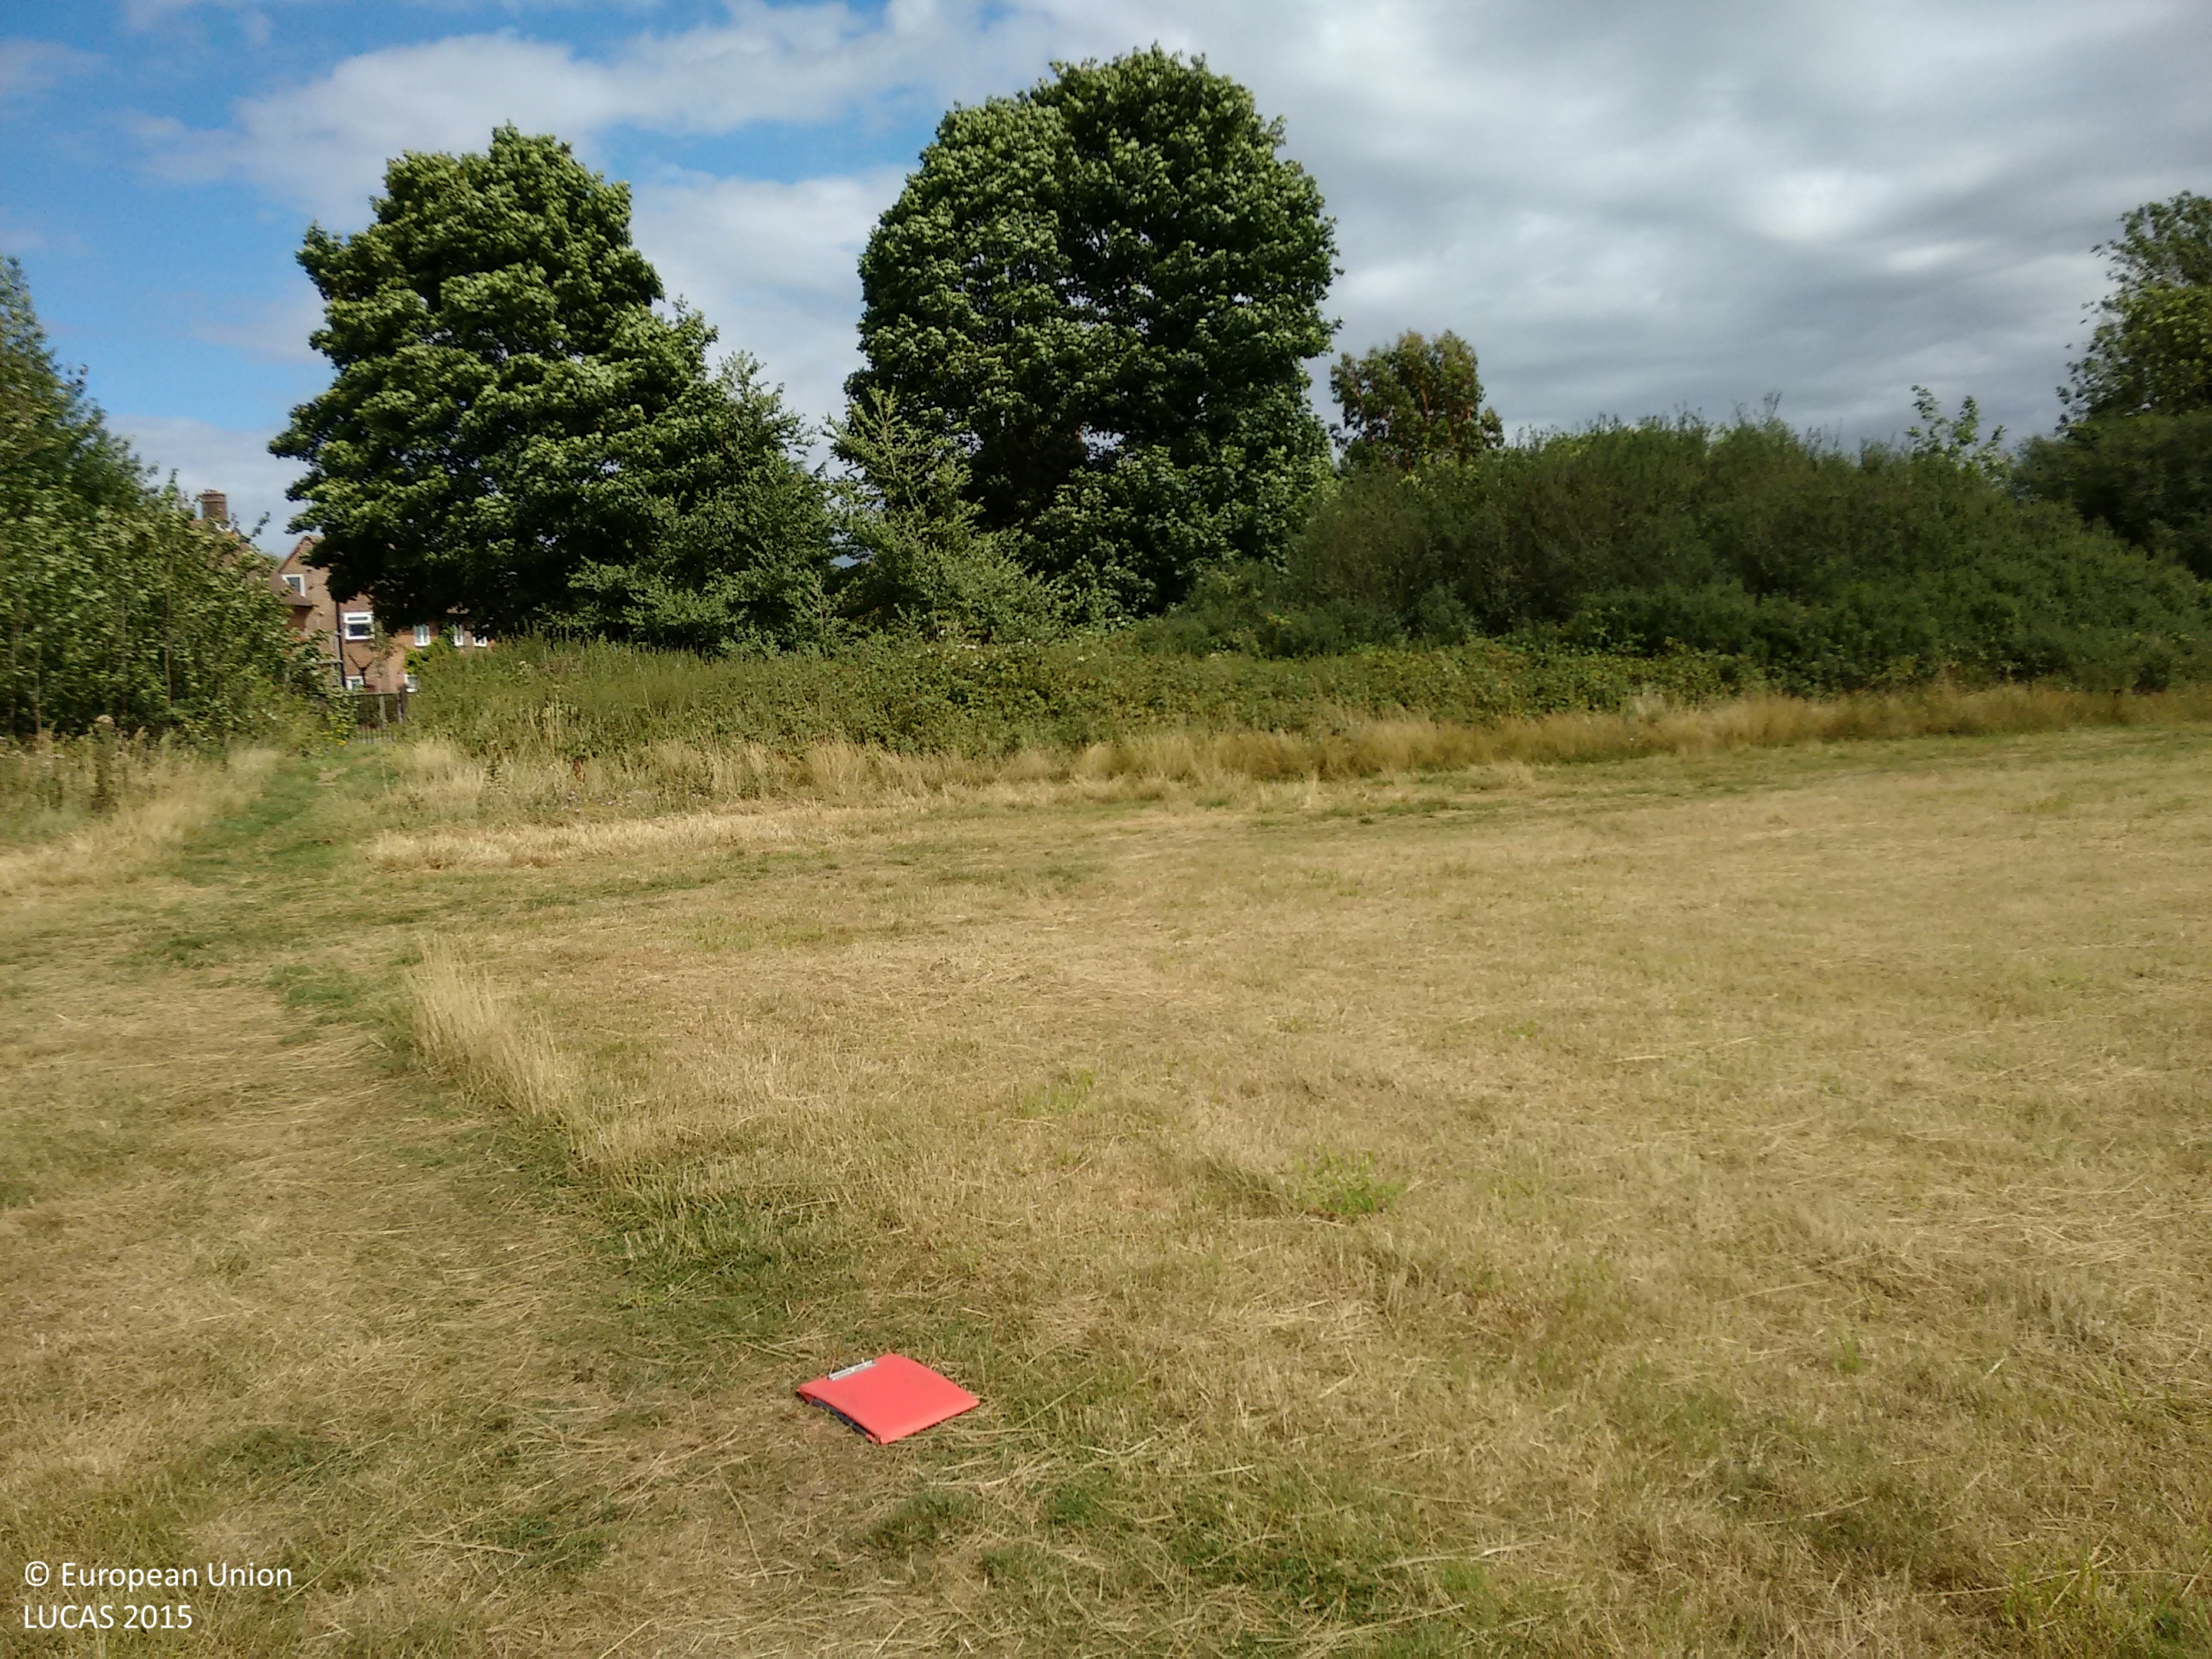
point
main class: Grassland
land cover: Grassland without tree/shrub cover
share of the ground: > 75 %
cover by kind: herbaceous plants 100 %
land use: Amenities, museums, leisure
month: August
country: GB
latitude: 51.3225
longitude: -0.1800
